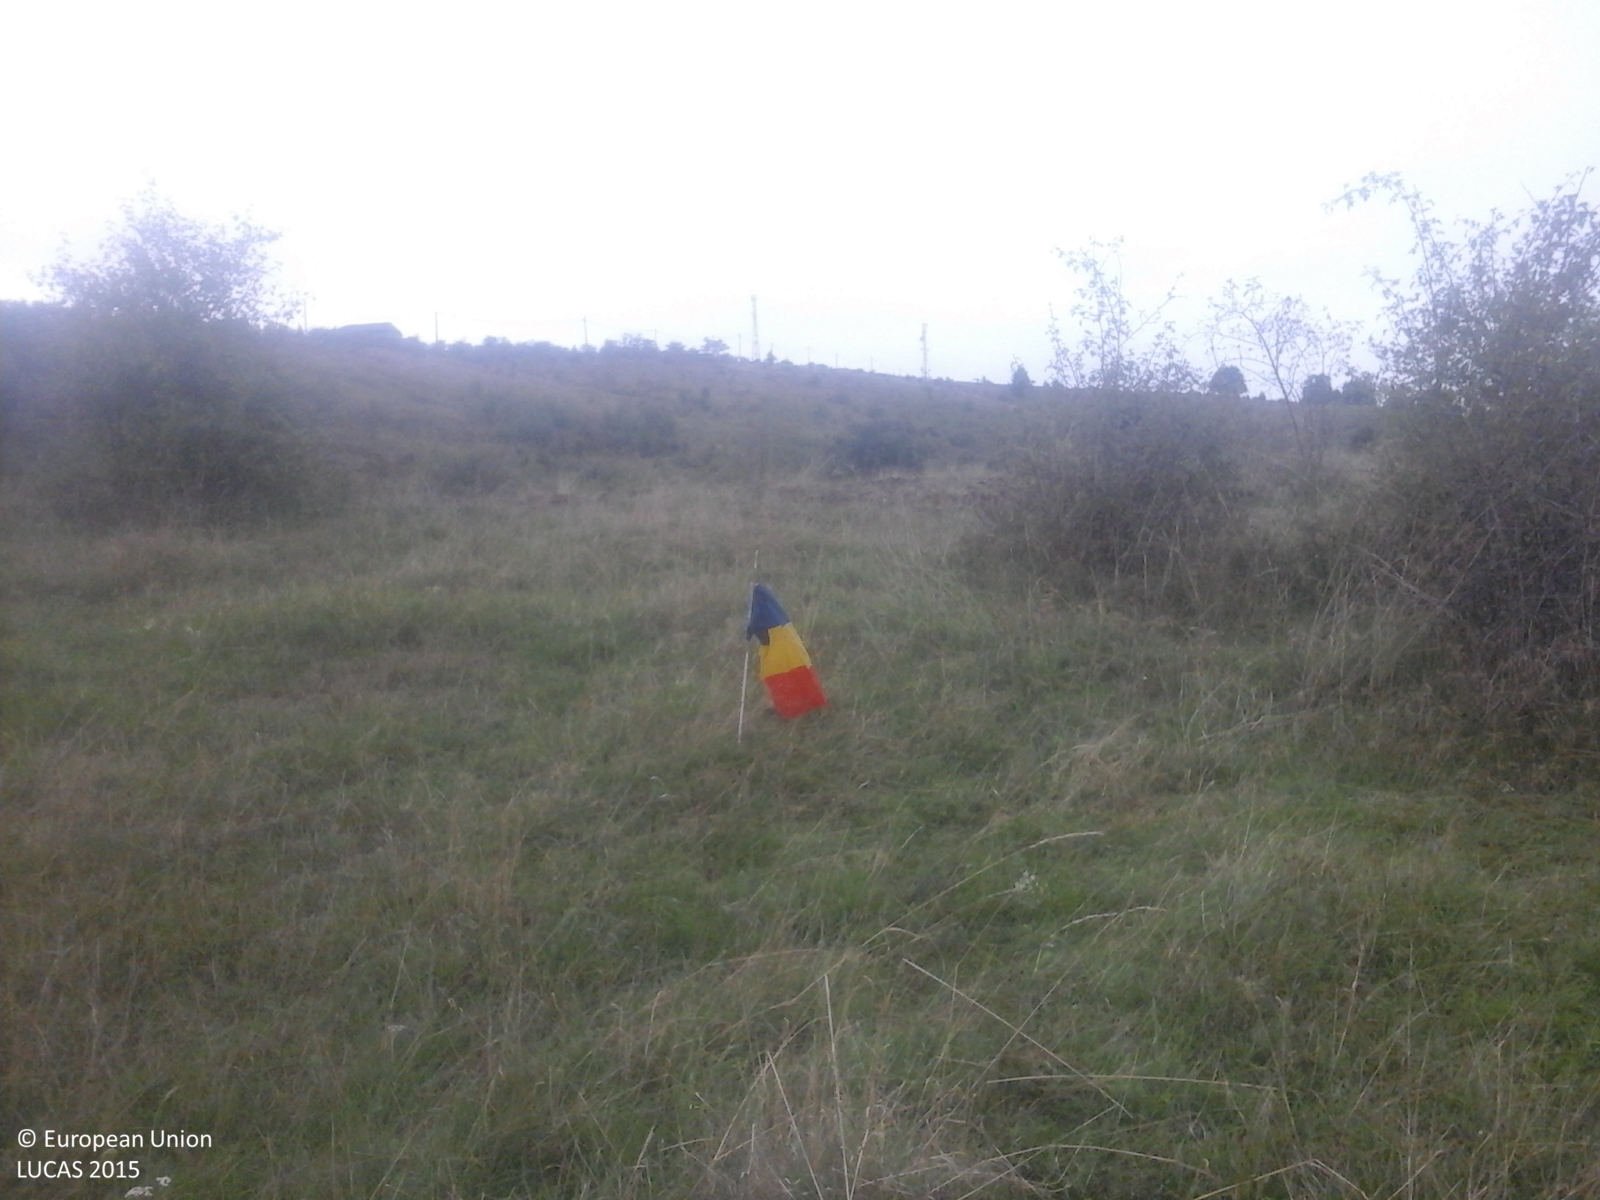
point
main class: Grassland
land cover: Grassland with sparse tree/shrub cover
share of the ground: > 75 %
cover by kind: herbaceous plants 85 %, shrubs 10 %, broadleaved forest trees 5 %
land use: Fallow land
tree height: < 5 m
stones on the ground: < 10 %
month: September
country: RO
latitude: 45.8067
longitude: 23.8769
